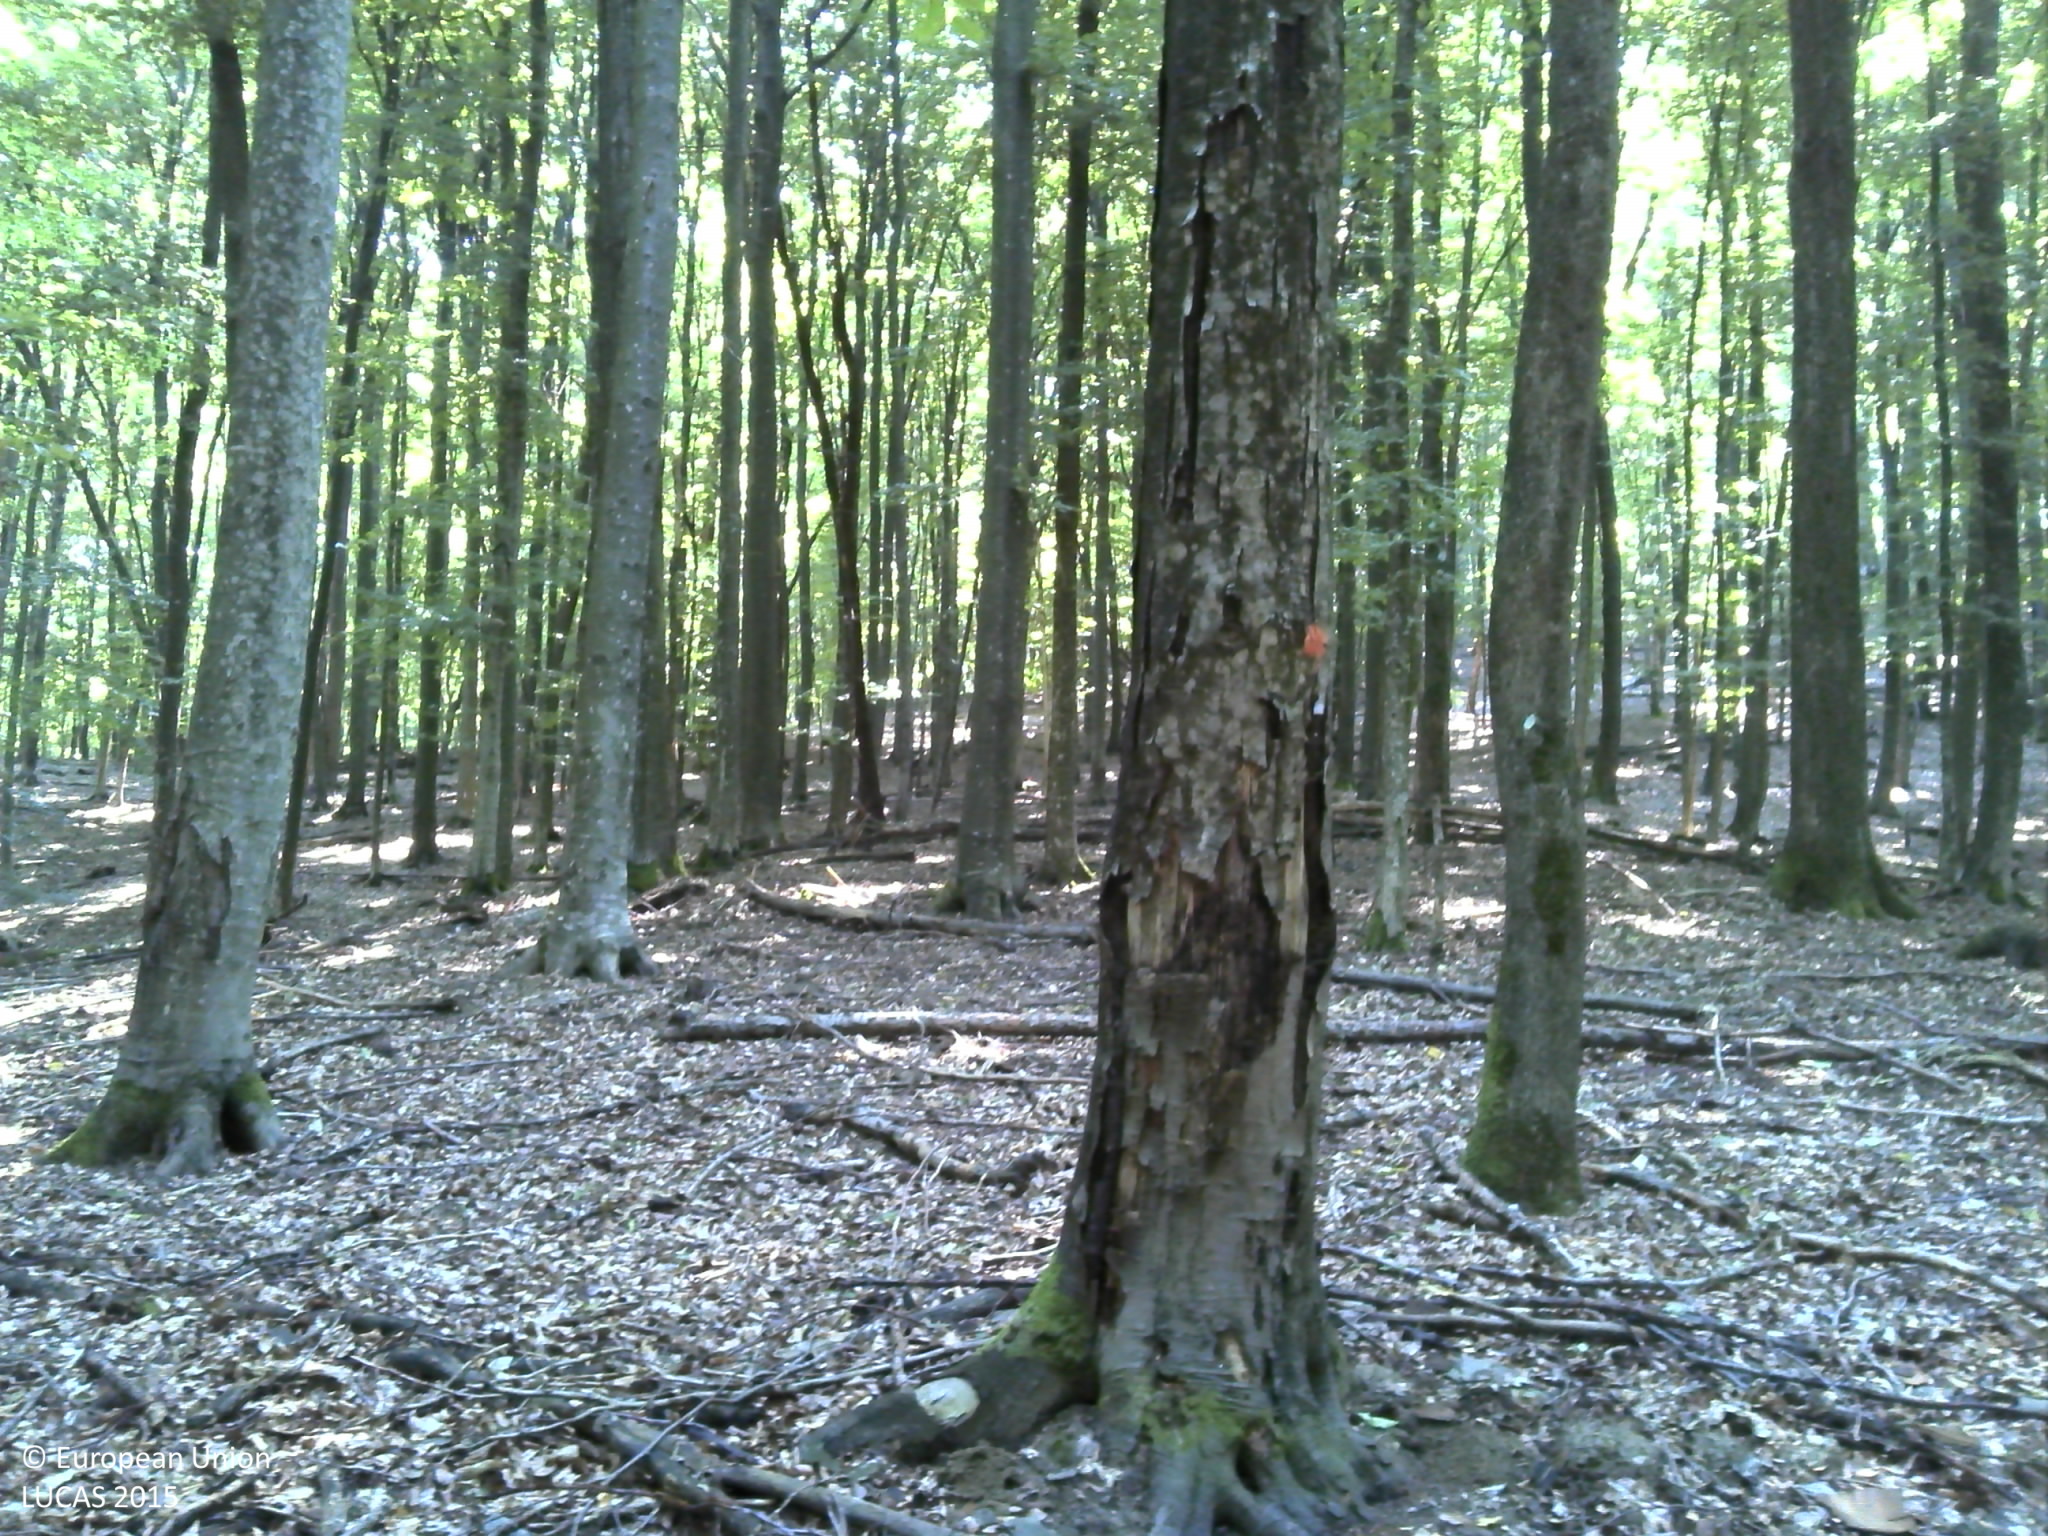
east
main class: Woodland
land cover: Broadleaved woodland
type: acidophilous oak and oak-birch forest
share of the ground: > 75 %
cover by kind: broadleaved forest trees 80 %, lichens and mosses 20 %
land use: Forestry
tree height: > 5 m
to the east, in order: Broadleaved woodland
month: July
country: HR
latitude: 45.5790
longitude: 16.7273
